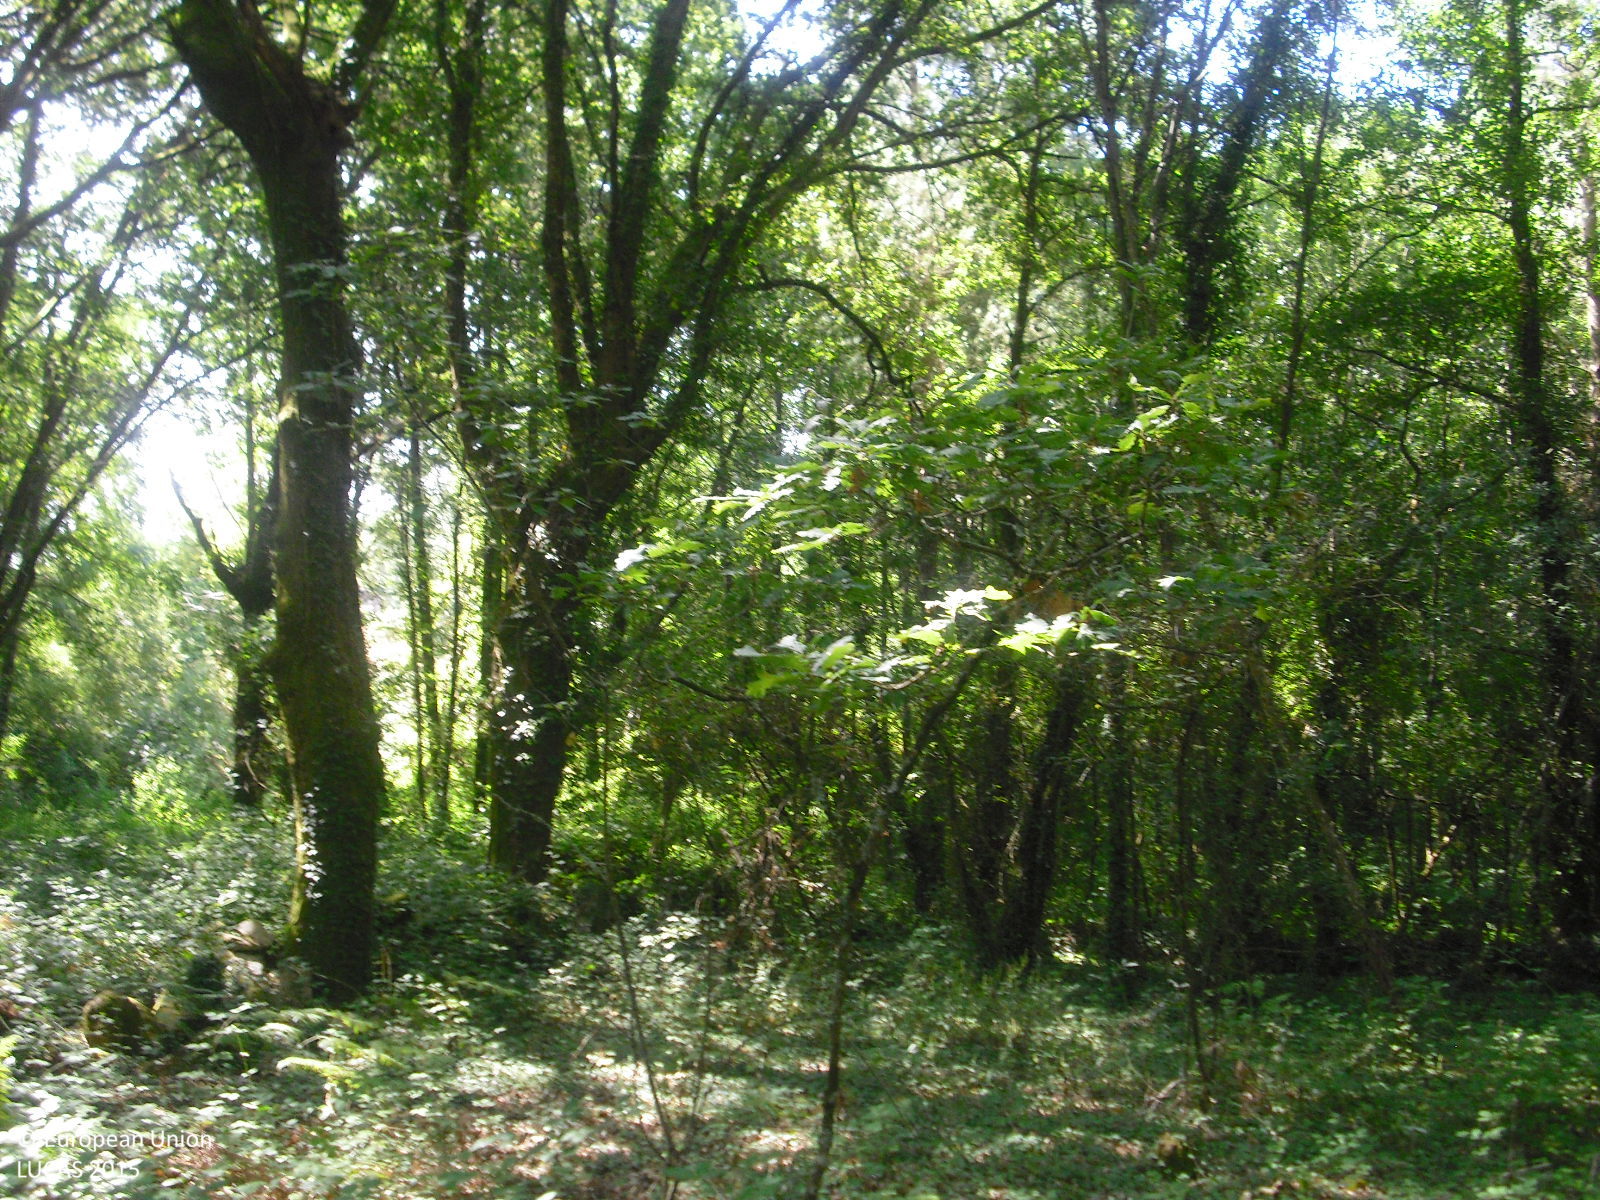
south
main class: Woodland
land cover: Broadleaved woodland
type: thermophilous deciduous forest
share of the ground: > 75 %
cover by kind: broadleaved forest trees 90 %, shrubs 10 %
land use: Forestry
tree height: > 5 m
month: July
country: ES
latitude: 42.3817
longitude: -7.7463
